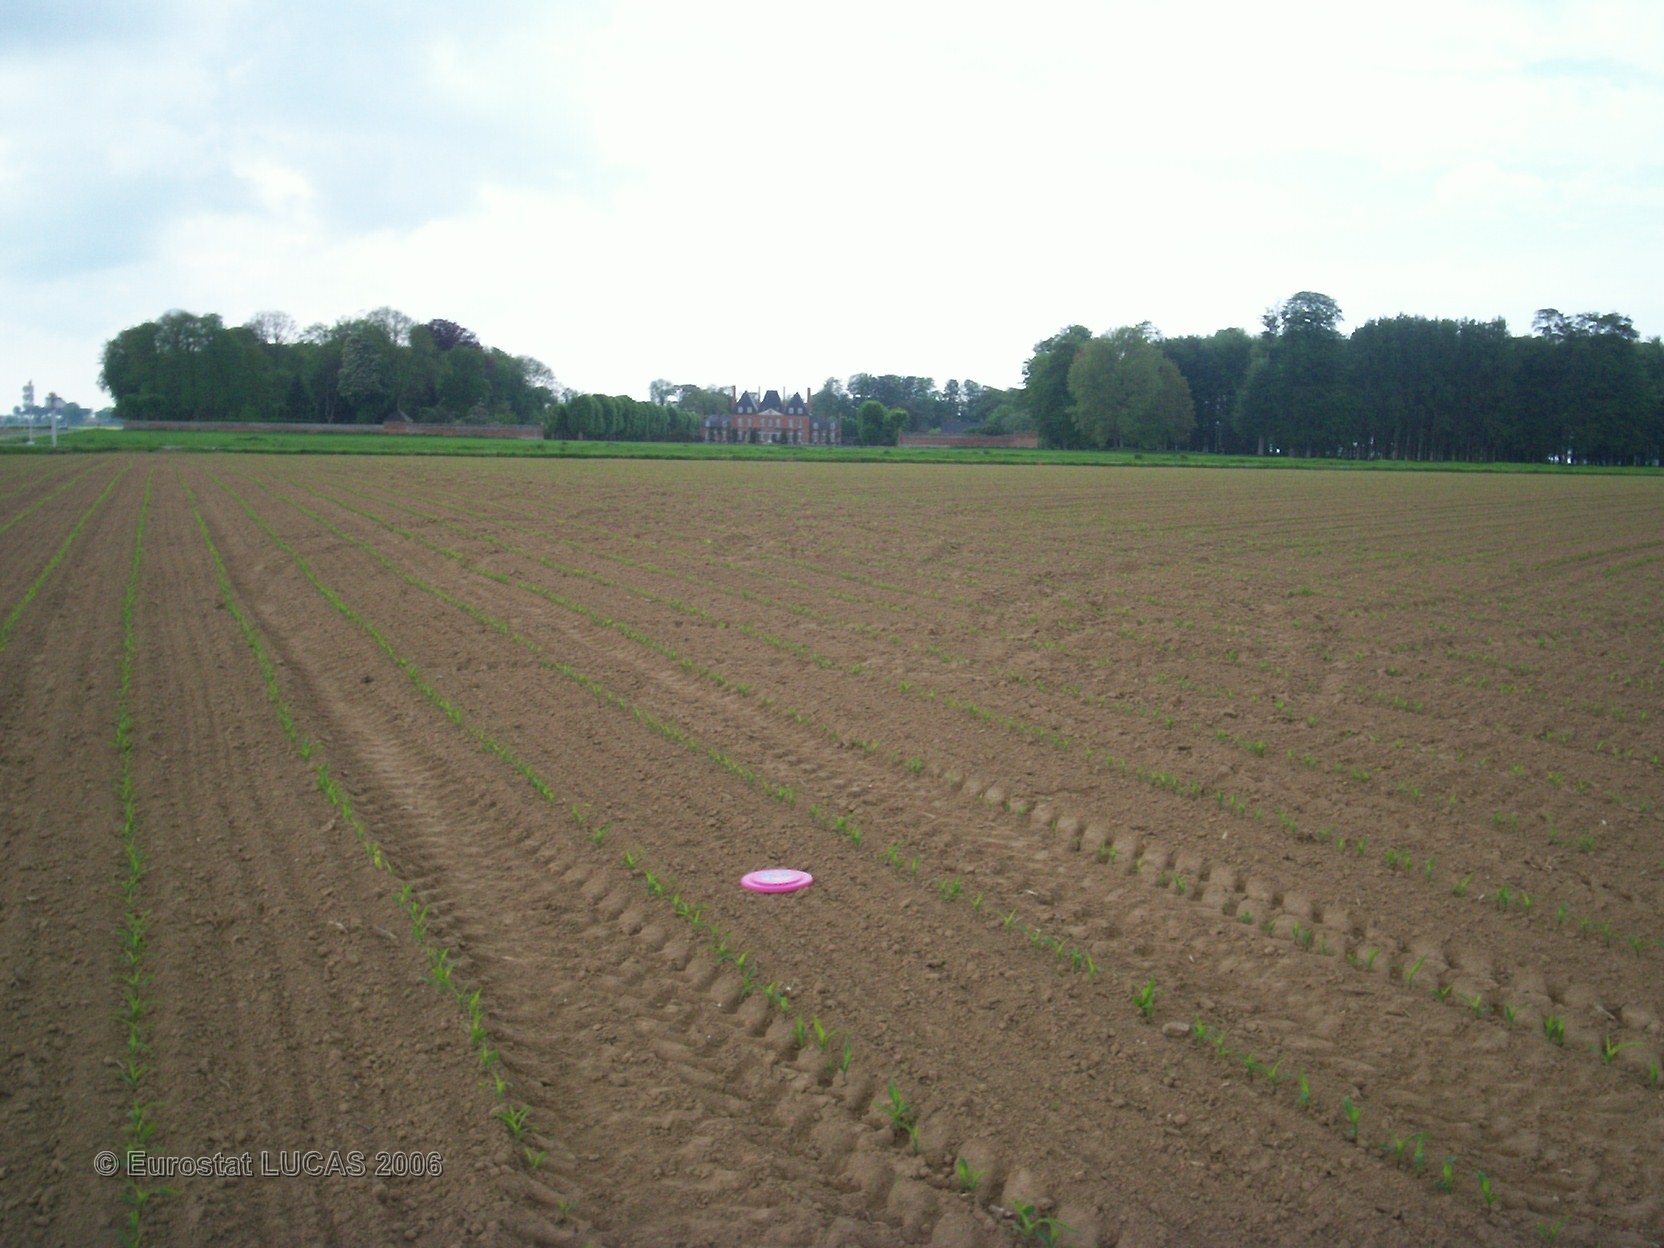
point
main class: Cropland
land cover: Maize
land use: Agriculture (excluding fallow land and kitchen gardens)
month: May
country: FR
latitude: 49.8108
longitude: 0.7900
